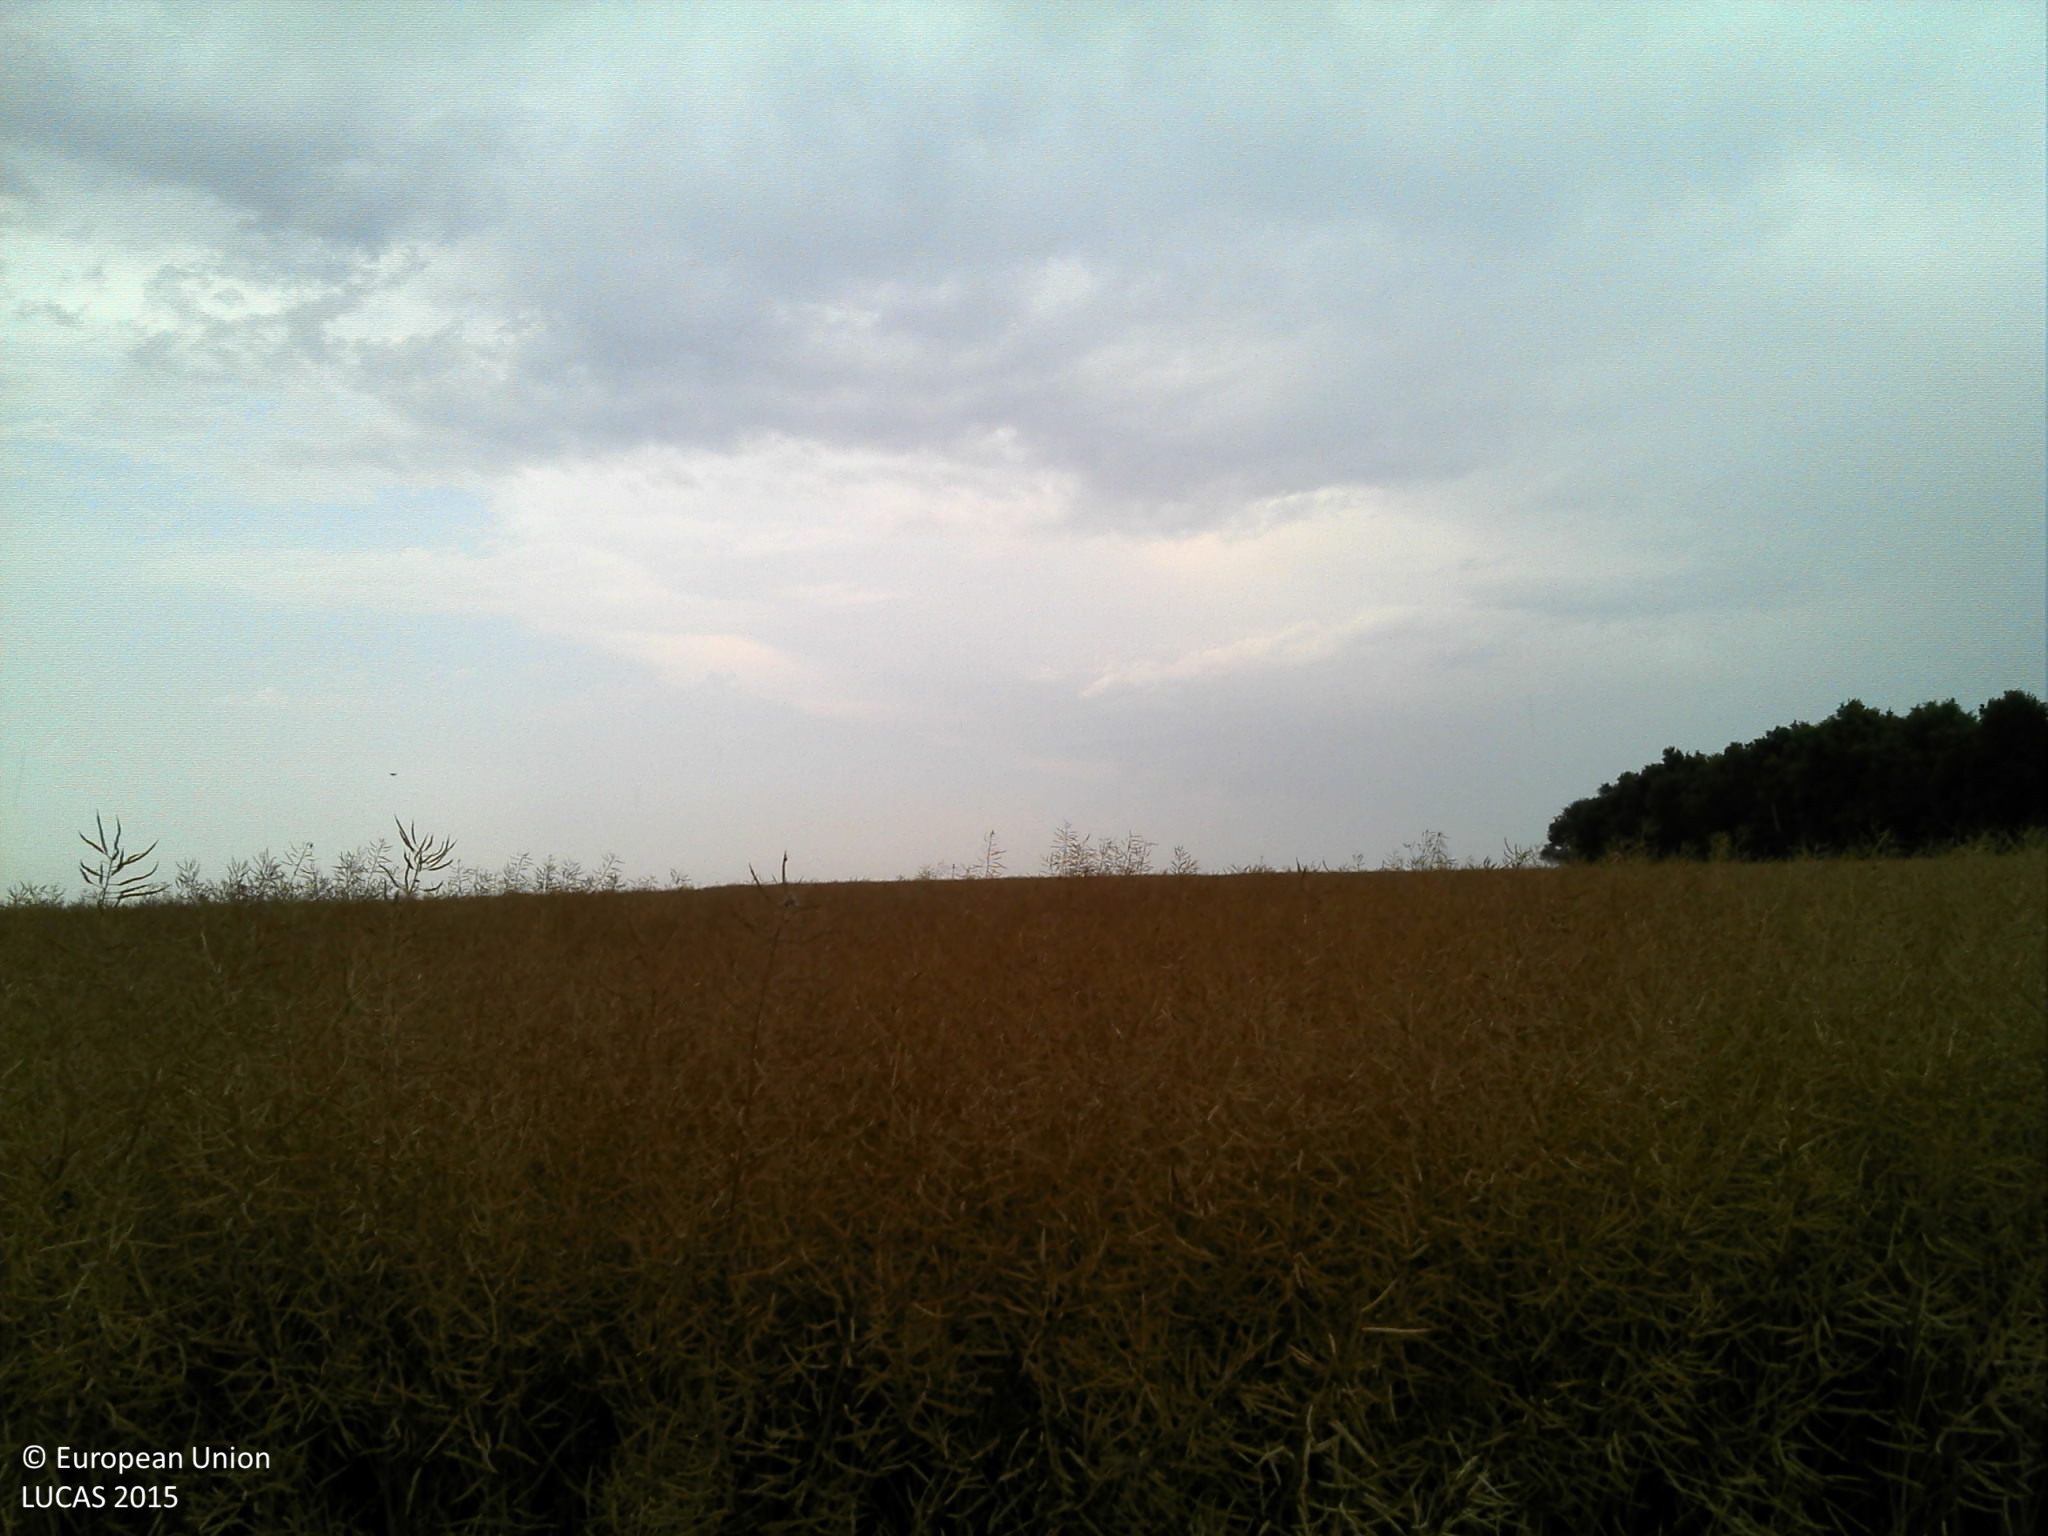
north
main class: Cropland
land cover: Rape and turnip rape
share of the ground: > 75 %
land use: Agriculture (excluding fallow land and kitchen gardens)
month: July
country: FR
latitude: 48.2919
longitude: 2.4821
